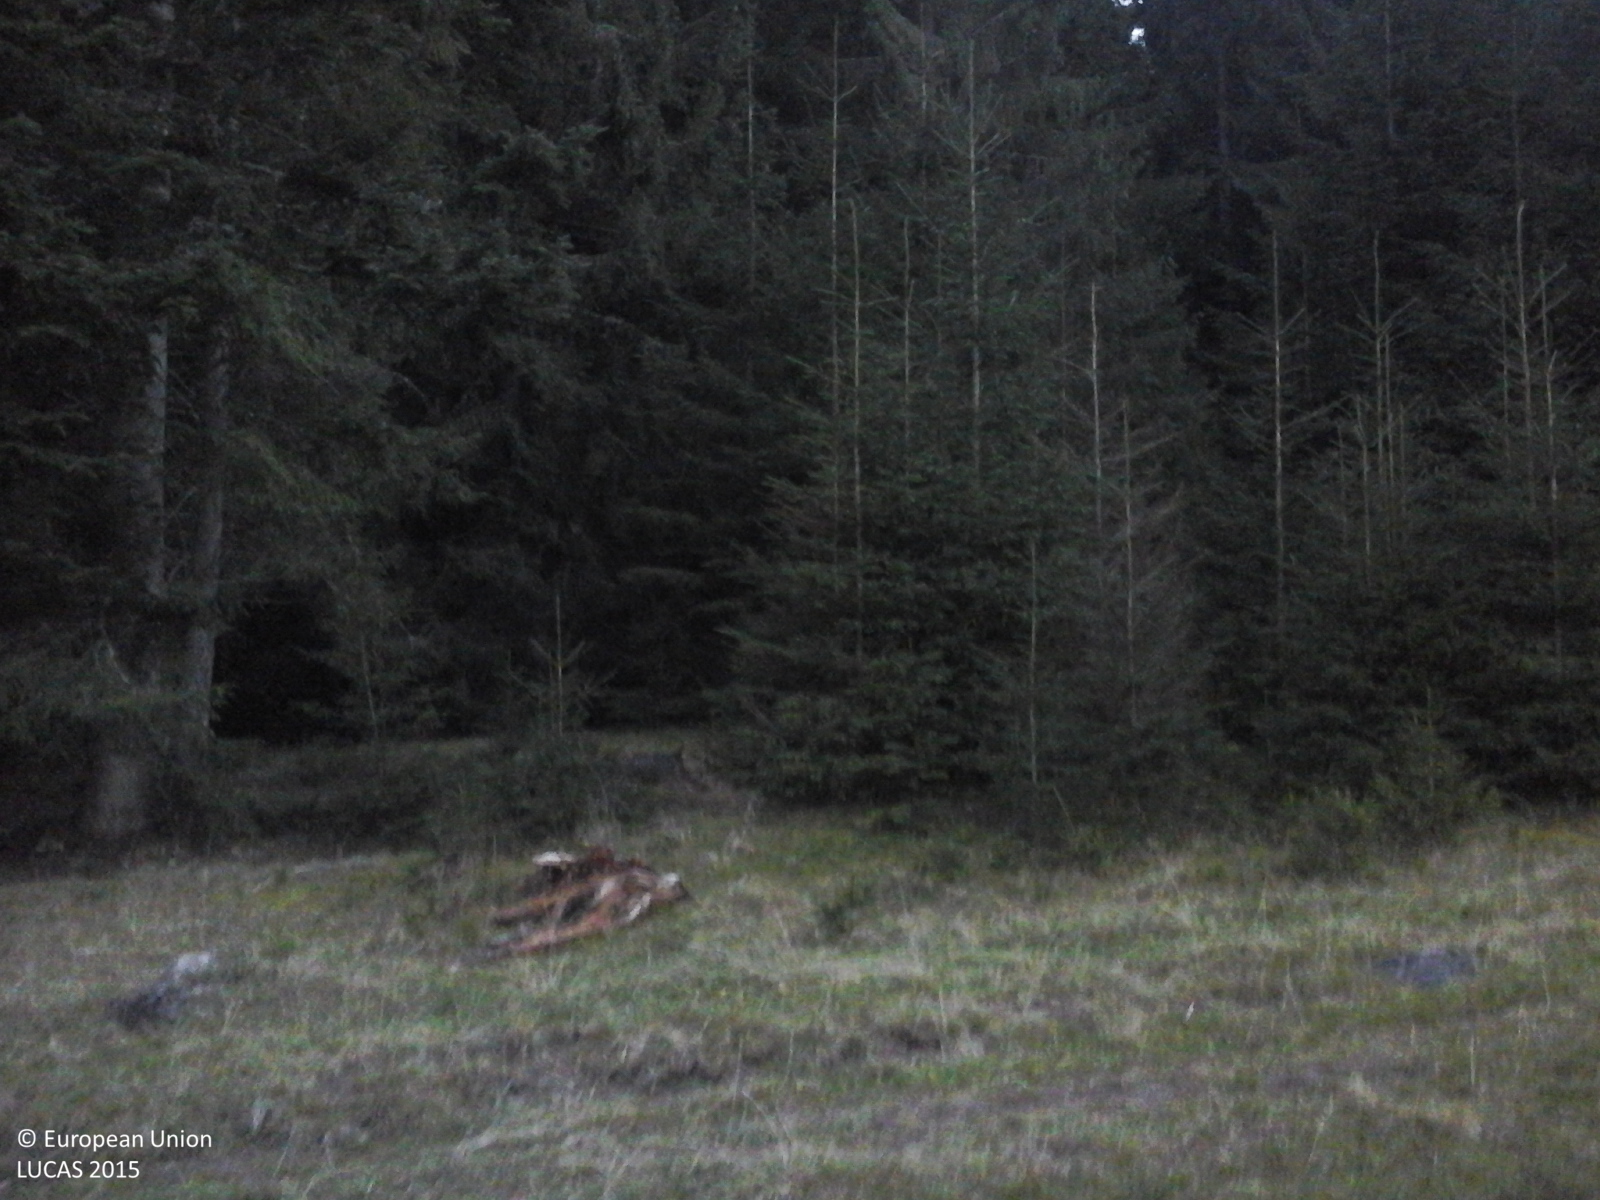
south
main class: Grassland
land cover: Spontaneously vegetated surfaces
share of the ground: > 75 %
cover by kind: herbaceous plants 100 %
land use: Fallow land
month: October
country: RO
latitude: 46.6377
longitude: 25.4047
